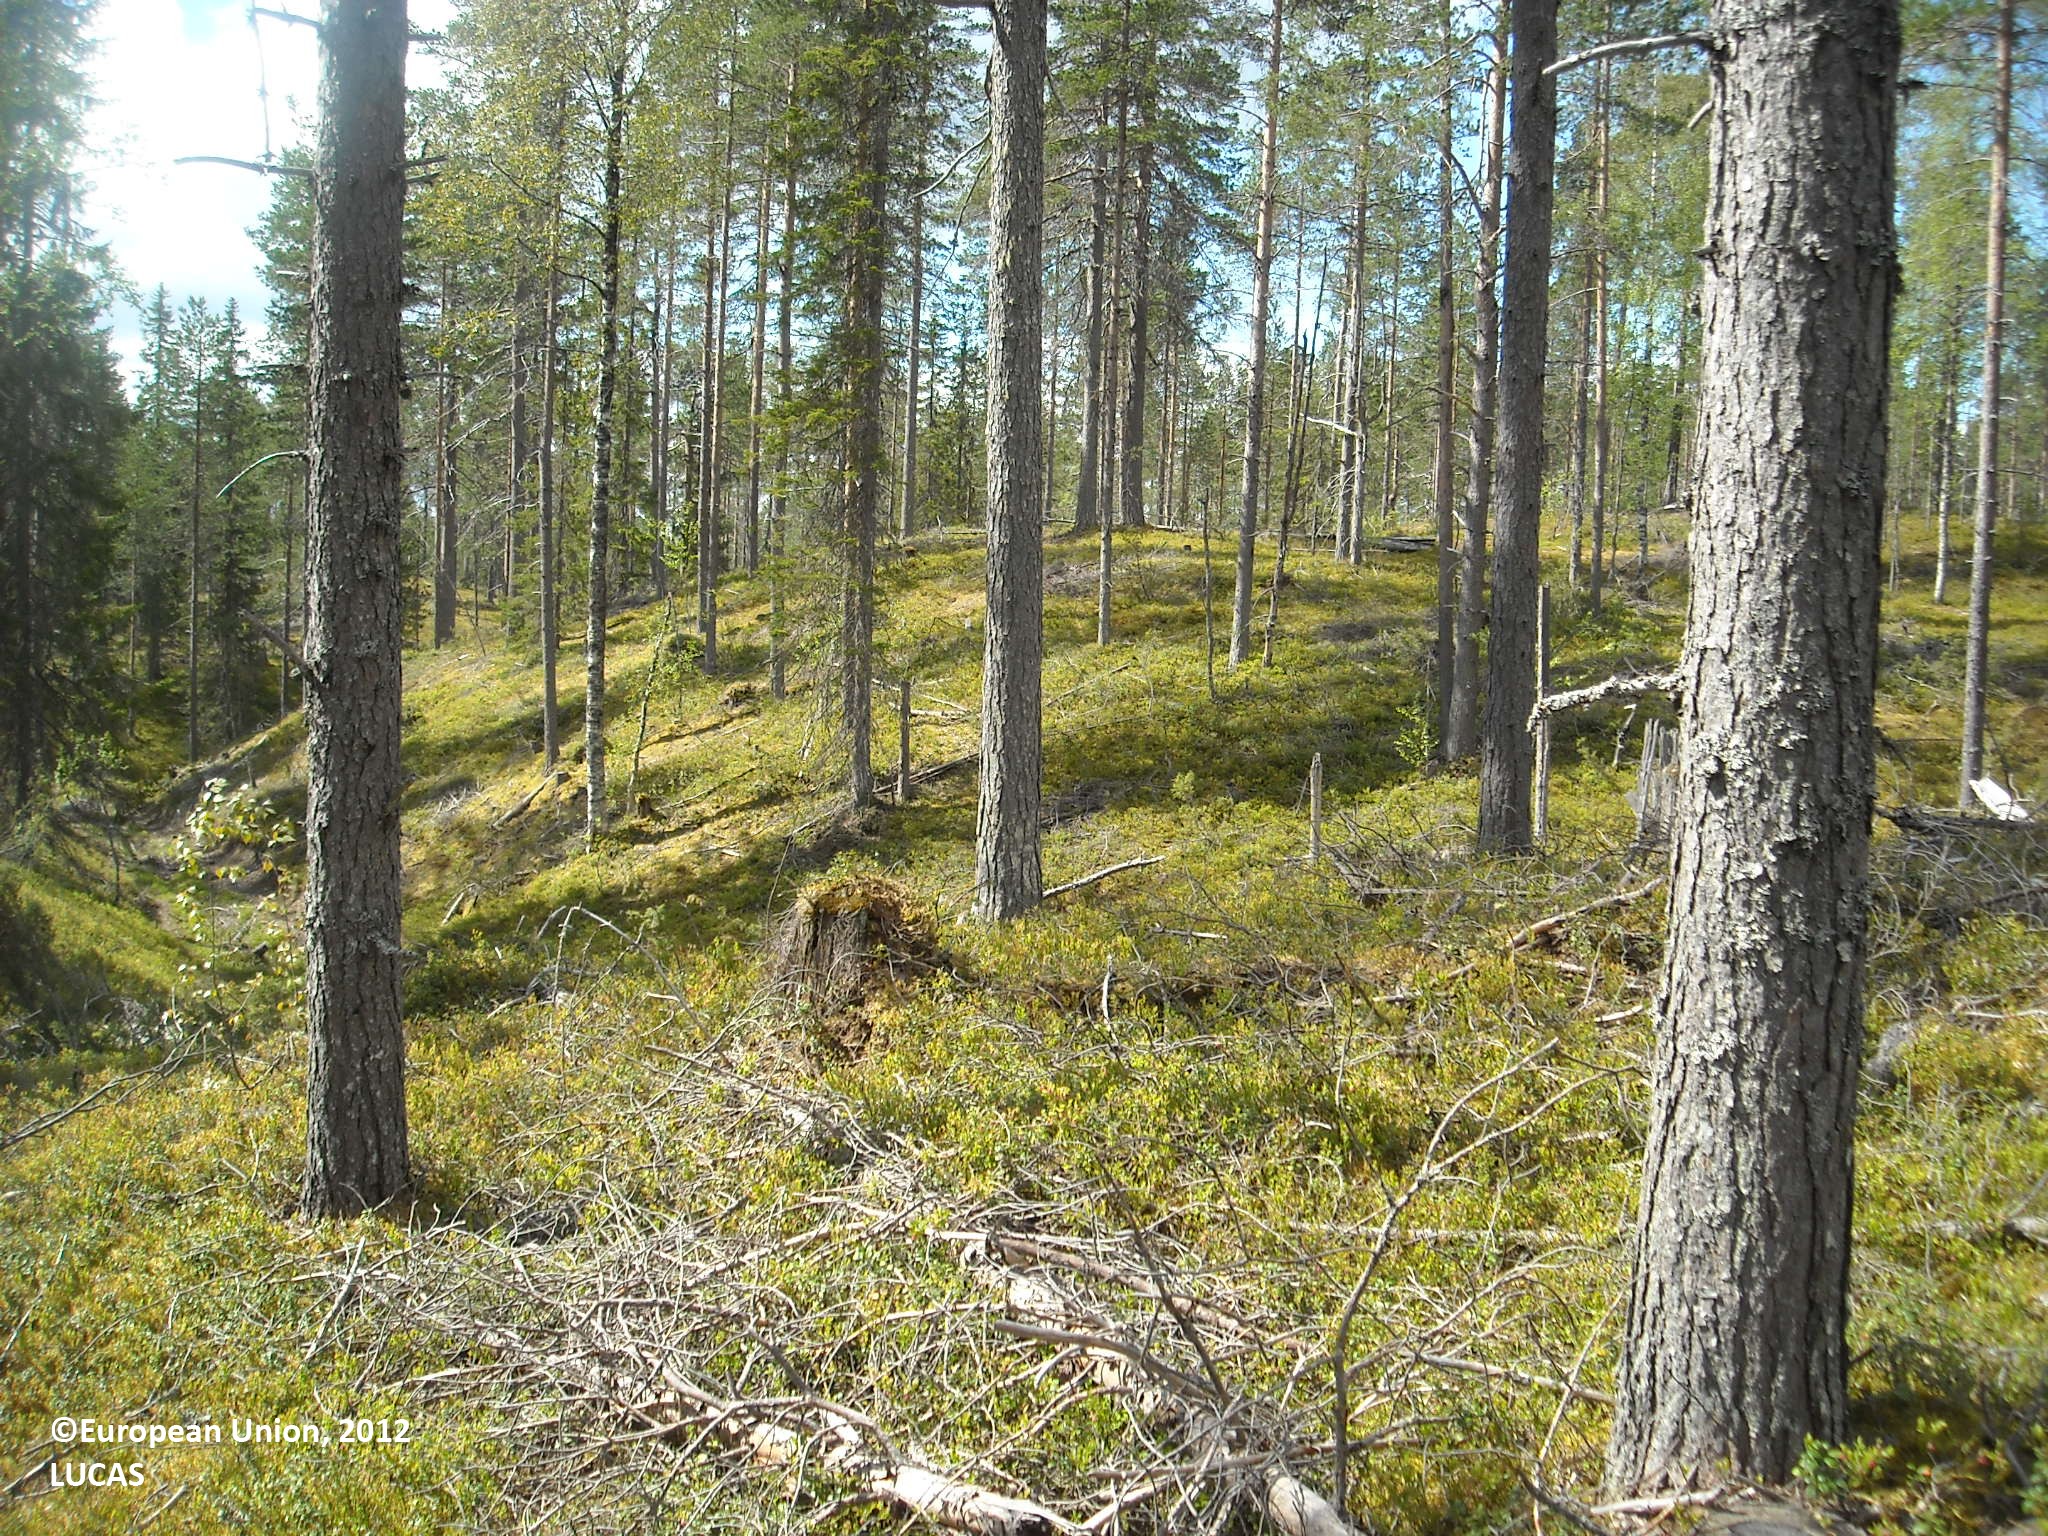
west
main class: Woodland
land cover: Pine dominated coniferous woodland
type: boreal forest
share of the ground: 50 - 75 %
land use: Forestry
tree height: > 5 m
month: June
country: FI
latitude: 65.3513
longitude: 27.8271
